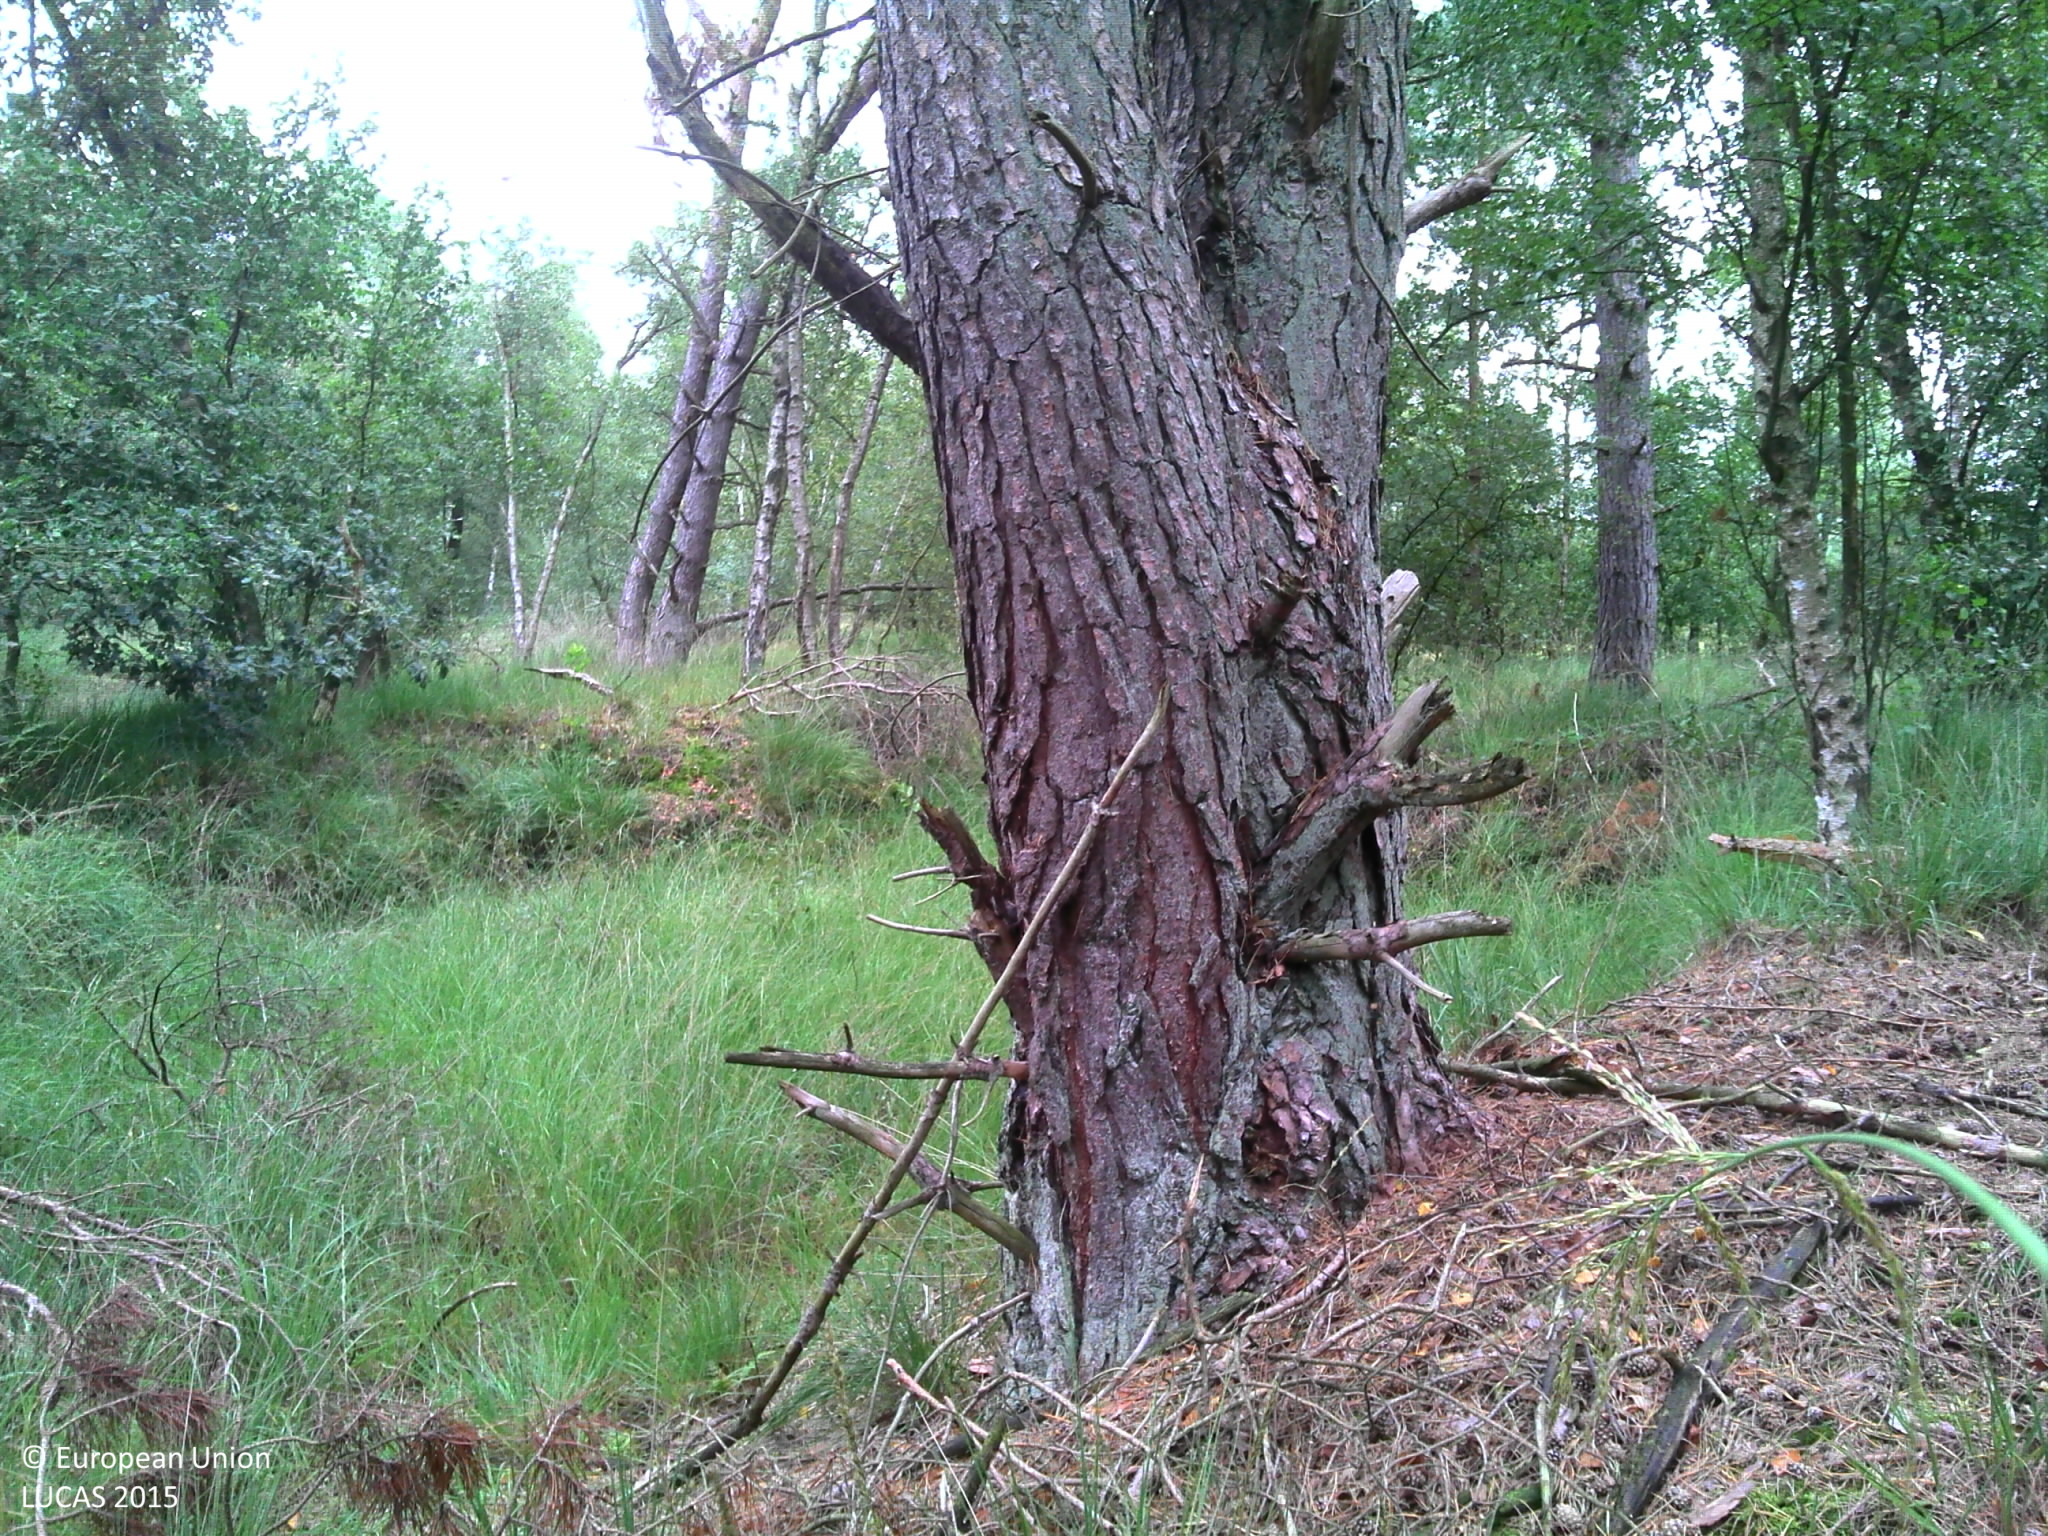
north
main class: Woodland
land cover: Pine dominated mixed woodland
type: acidophilous oak and oak-birch forest
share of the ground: > 75 %
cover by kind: coniferous forest trees 40 %, broadleaved forest trees 35 %, herbaceous plants 25 %
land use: Community services
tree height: > 5 m
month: September
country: BE
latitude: 51.3490
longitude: 4.4967
